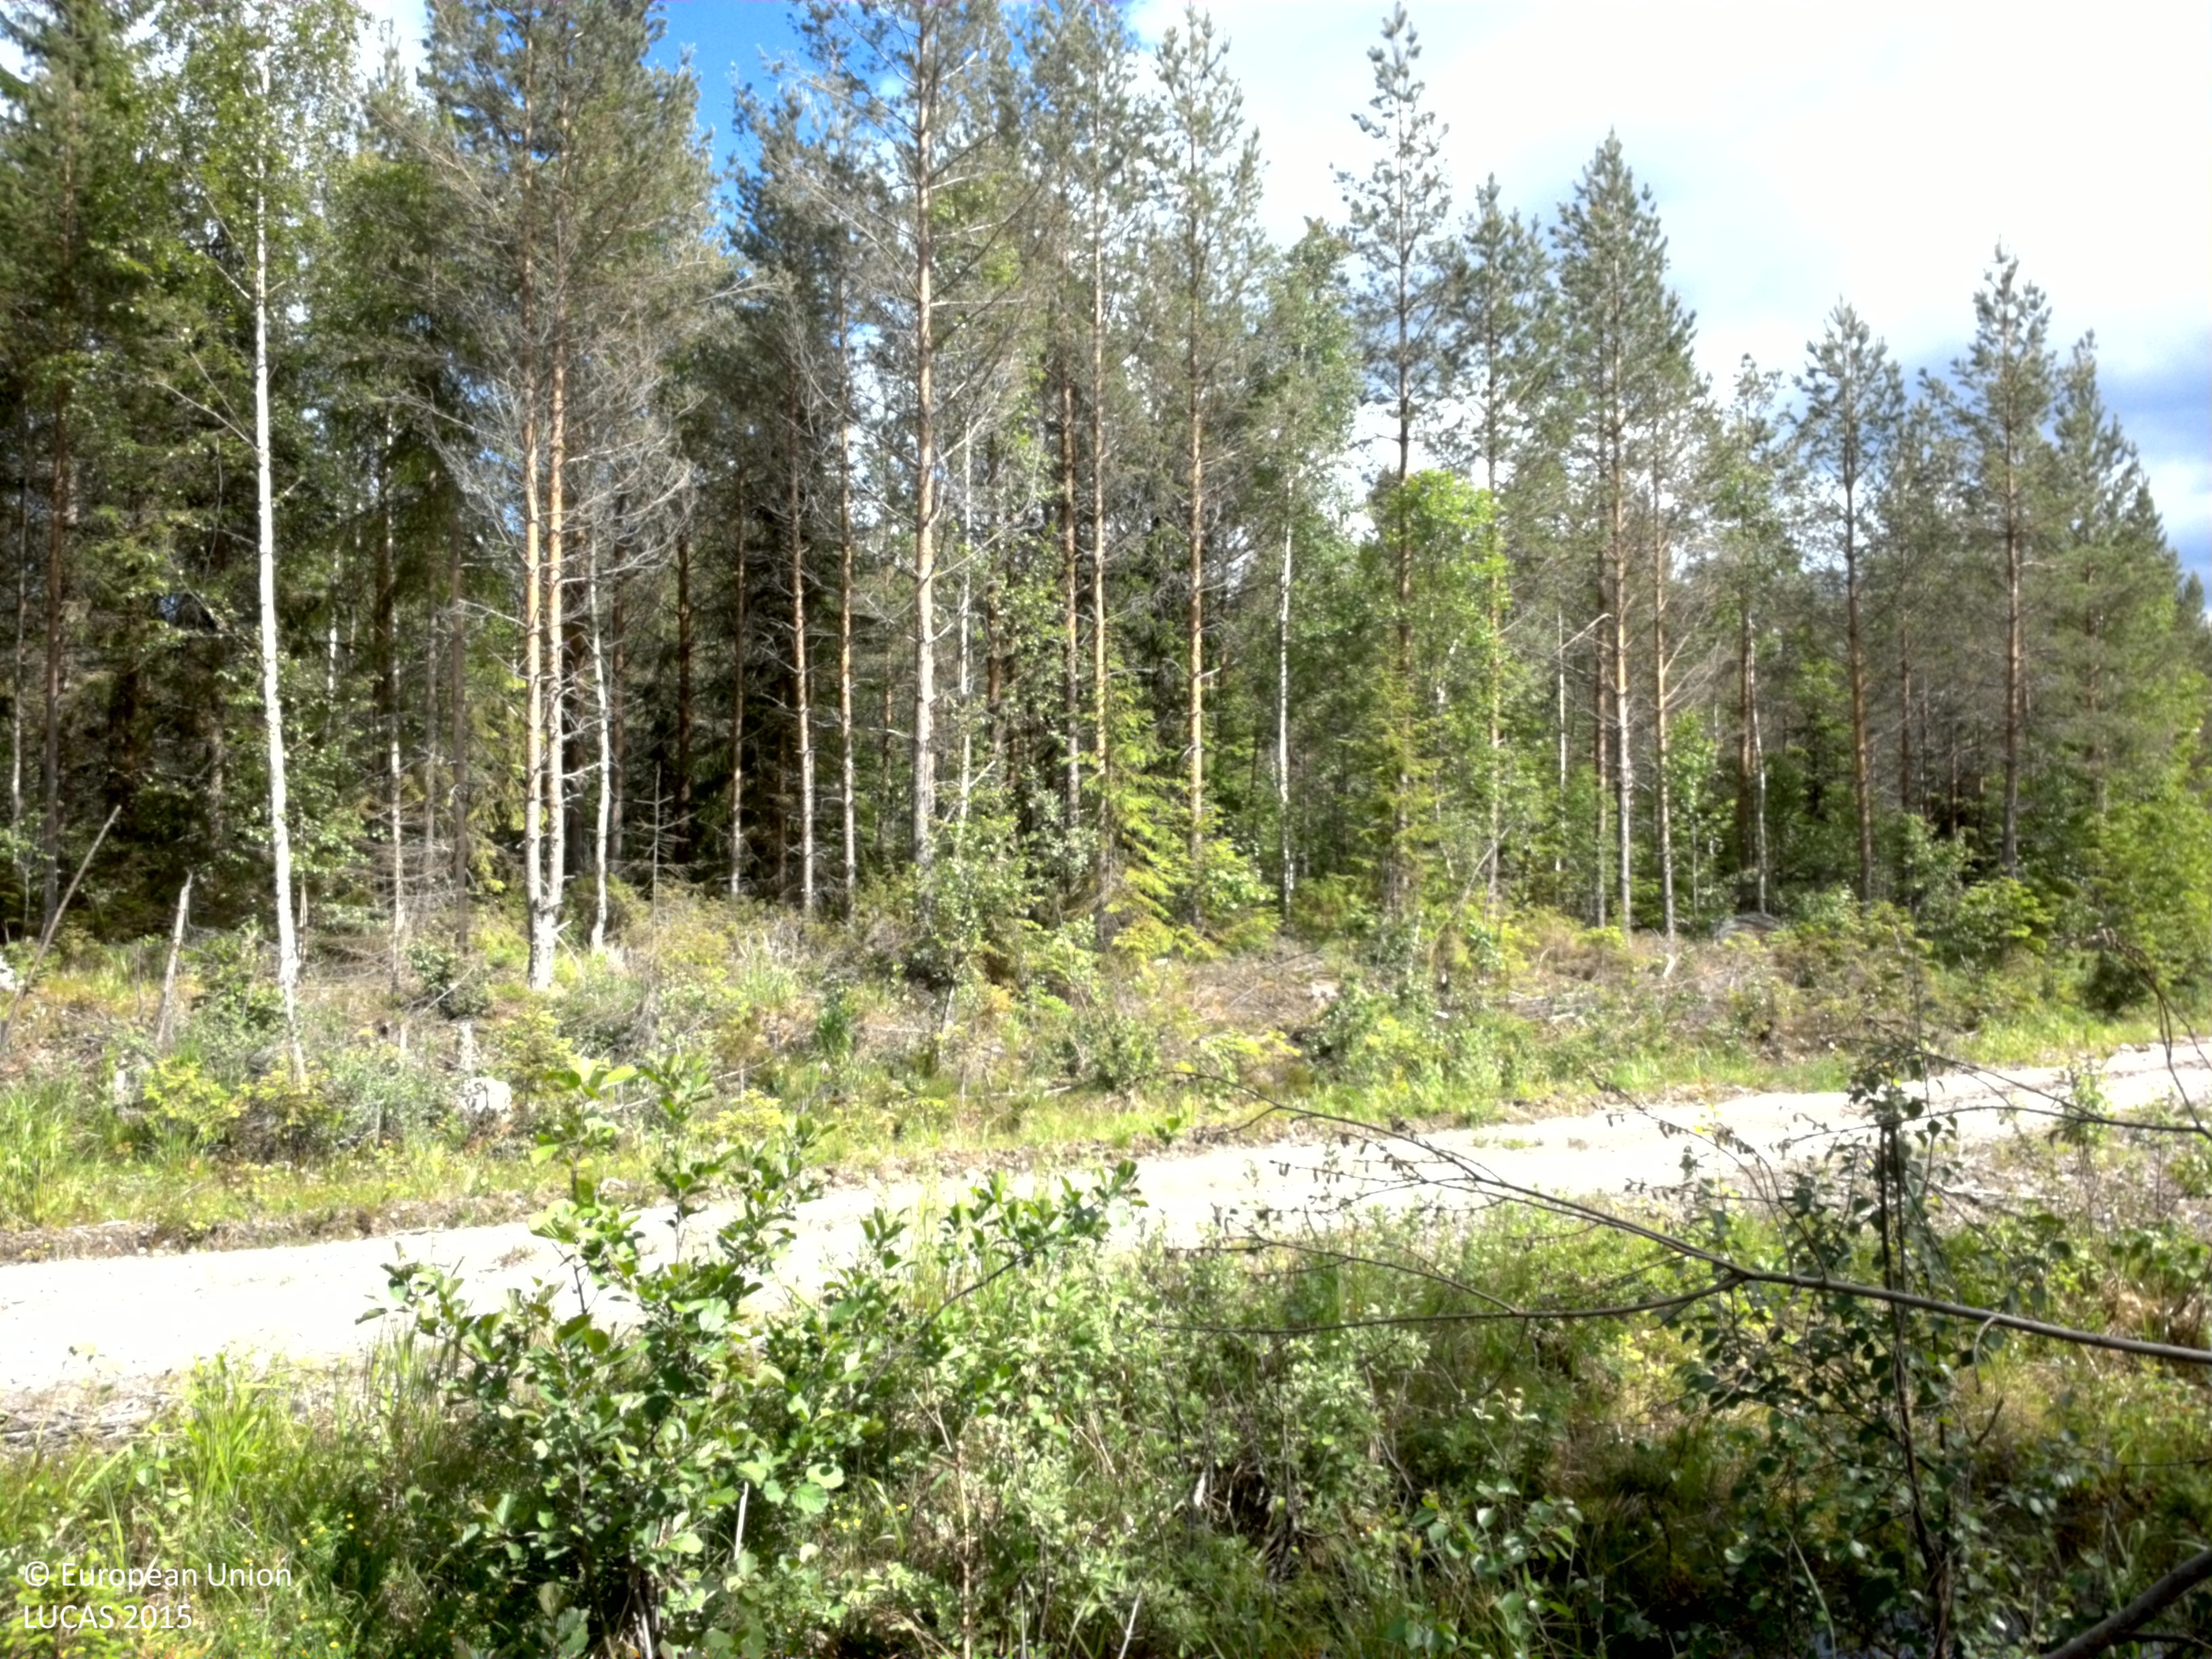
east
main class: Woodland
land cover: Broadleaved woodland
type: hemiboreal forest and nemoral coniferous forest and mixed broadleaved-coniferous forest
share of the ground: 10 - 25 %
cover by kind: herbaceous plants 35 %, broadleaved forest trees 15 %, coniferous forest trees 5 %, shrubs 5 %
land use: Forestry
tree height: > 5 m
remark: Clear cut
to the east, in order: Broadleaved woodland; Ditches and canals; Grass margins; Paved roads, cycling and walking lanes; Grass margins; Ditches and canals; Pine dominated coniferous woodland; Ditches and canals; Spruce dominated mixed woodland; Pine dominated mixed woodland; Pine dominated coniferous woodland
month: June
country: SE
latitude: 60.2035
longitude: 17.0450
